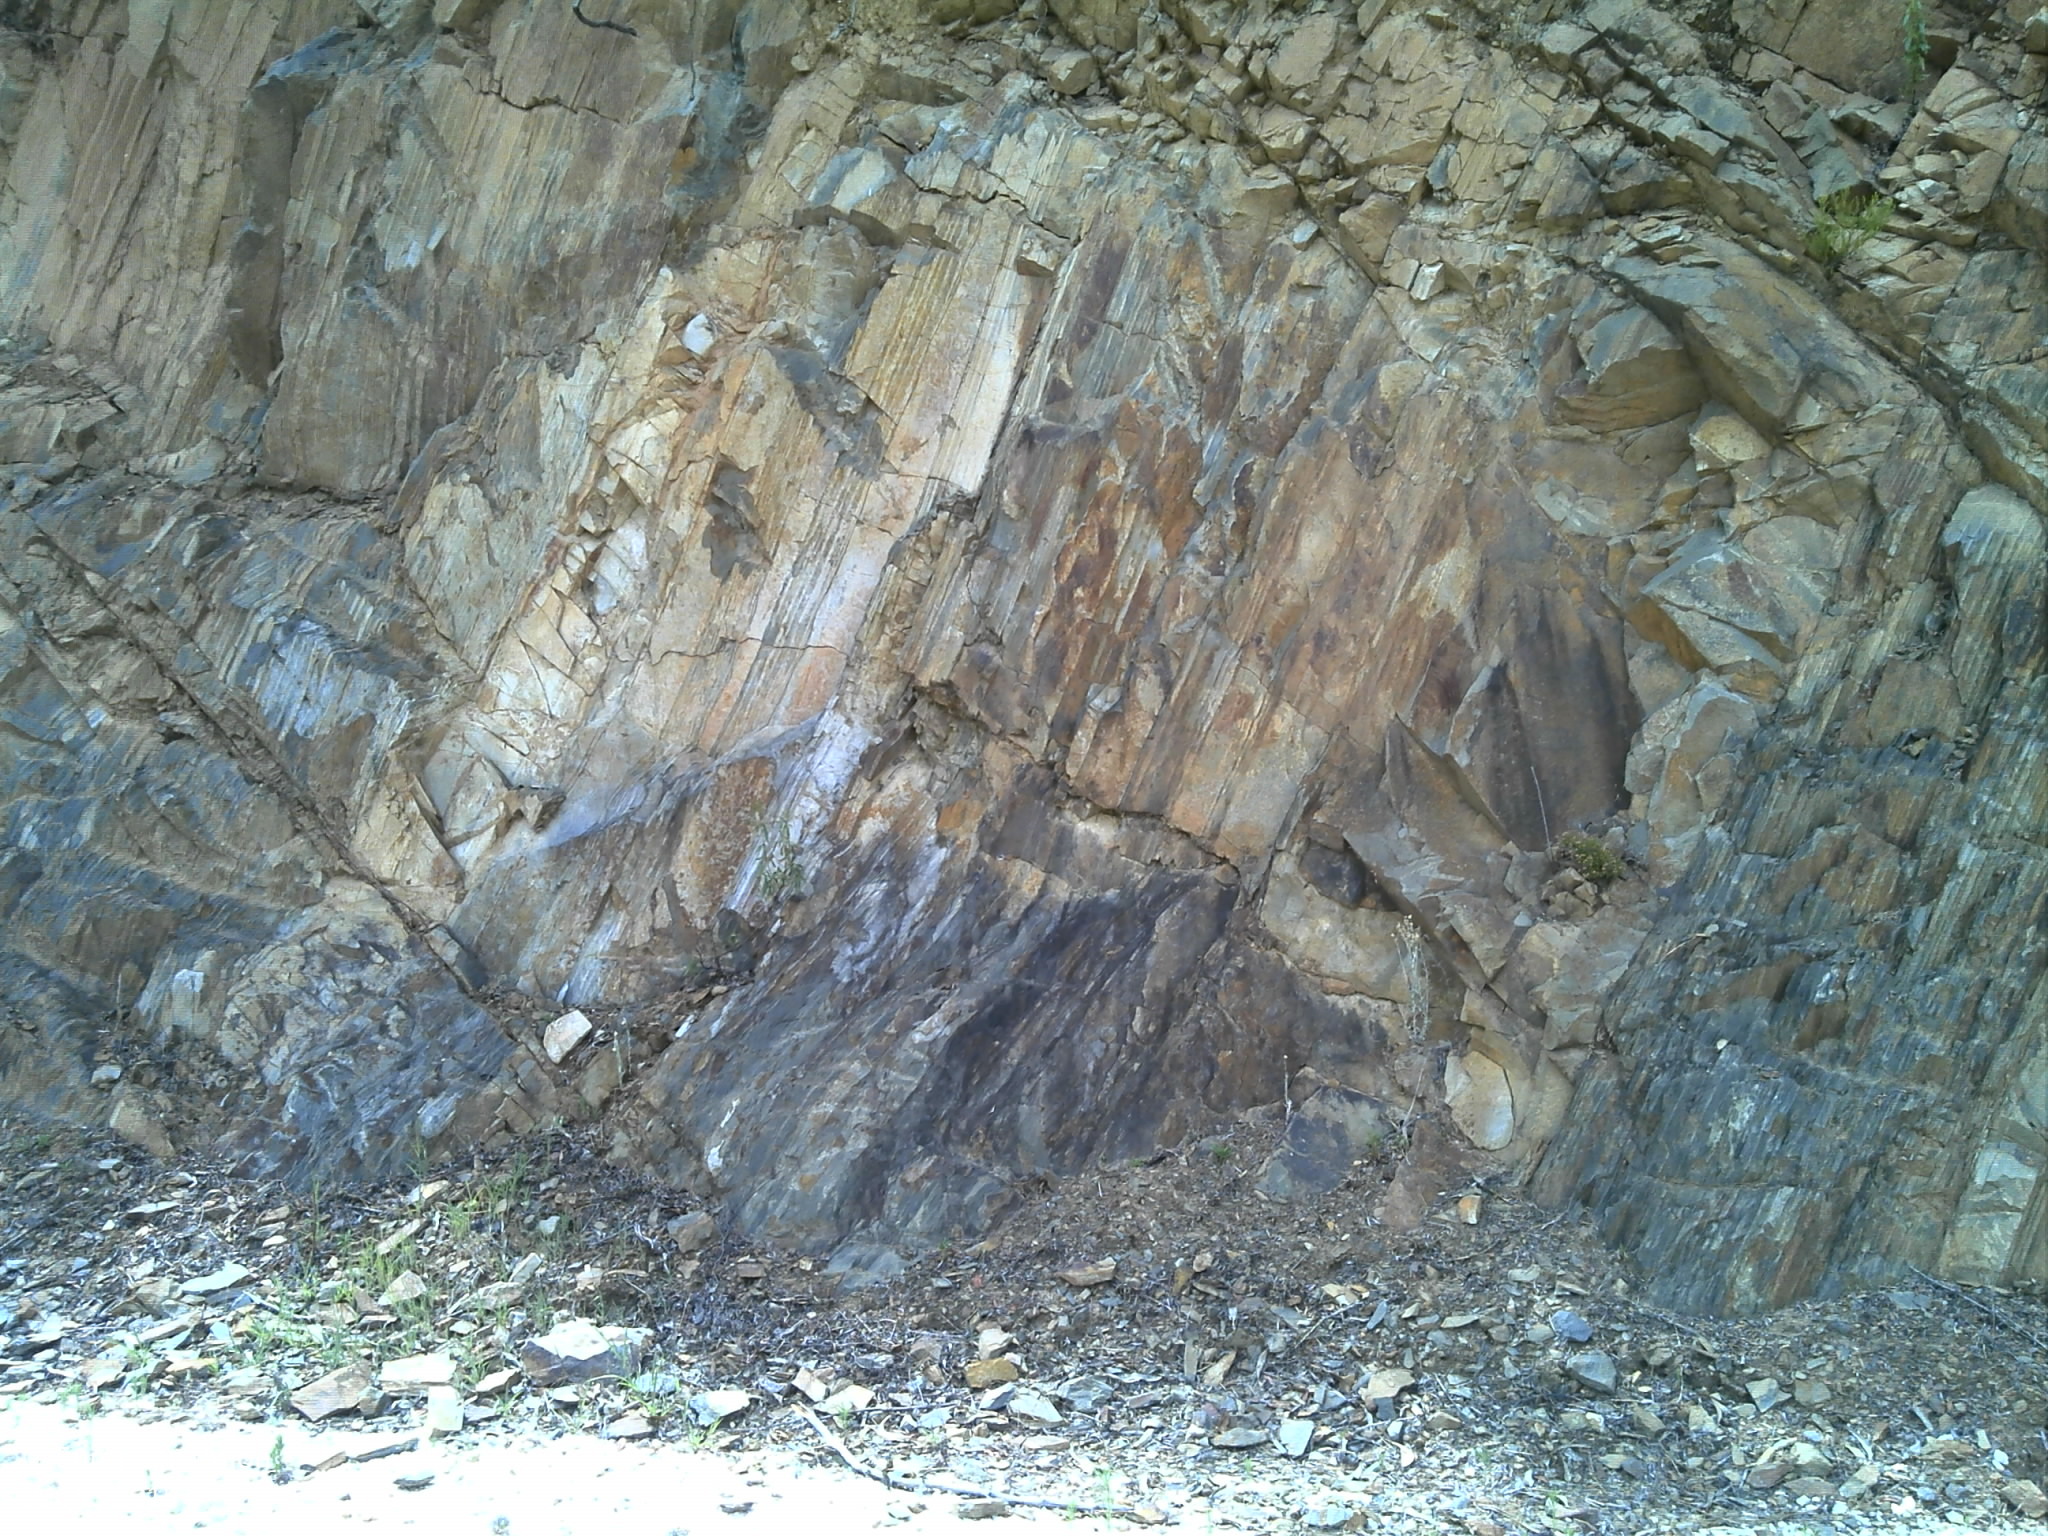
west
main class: Shrubland
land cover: Shrubland with sparse tree cover
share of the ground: 25 - 50 %
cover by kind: shrubs 35 %, consolidated bare surface 30 %, unconsolidated bare surface 30 %, broadleaved forest trees 5 %
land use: Semi-natural and natural areas not in use
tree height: < 5 m
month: July
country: PT
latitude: 39.8604
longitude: -8.0094
